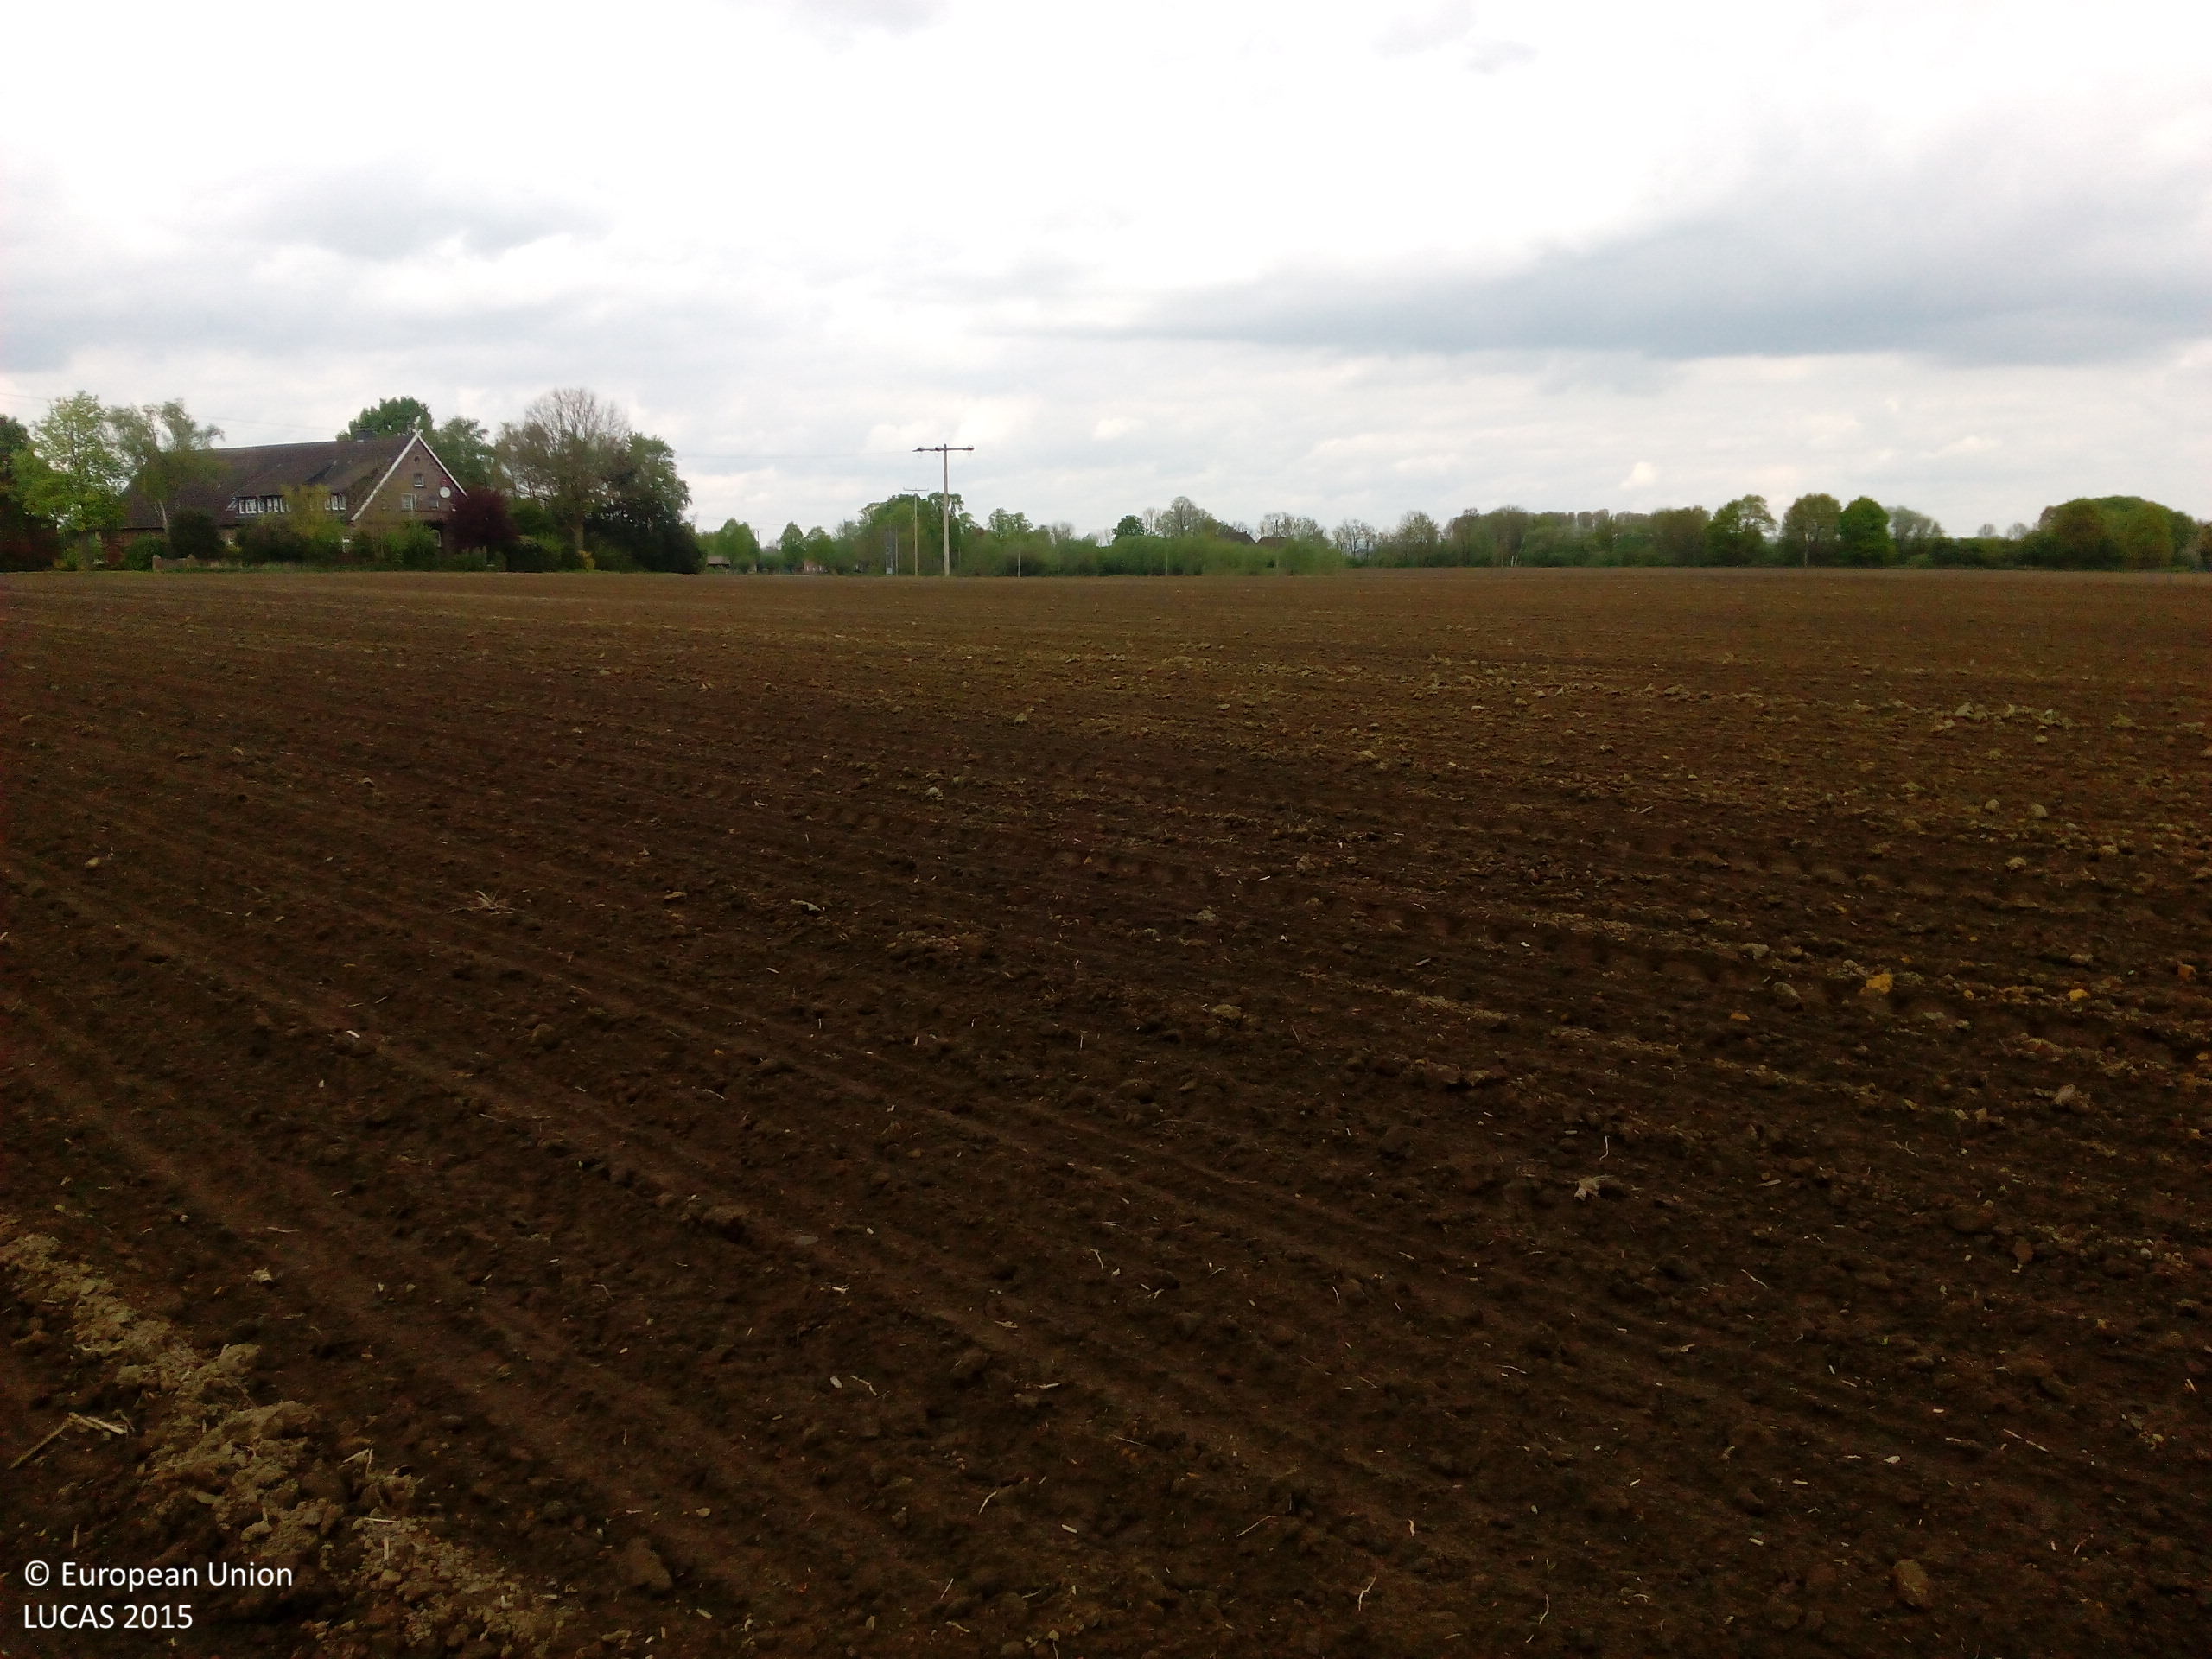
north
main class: Cropland
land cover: Maize
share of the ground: < 10 %
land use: Agriculture (excluding fallow land and kitchen gardens)
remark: Tilled/Sowed
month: May
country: DE
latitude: 51.7910
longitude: 7.3761
